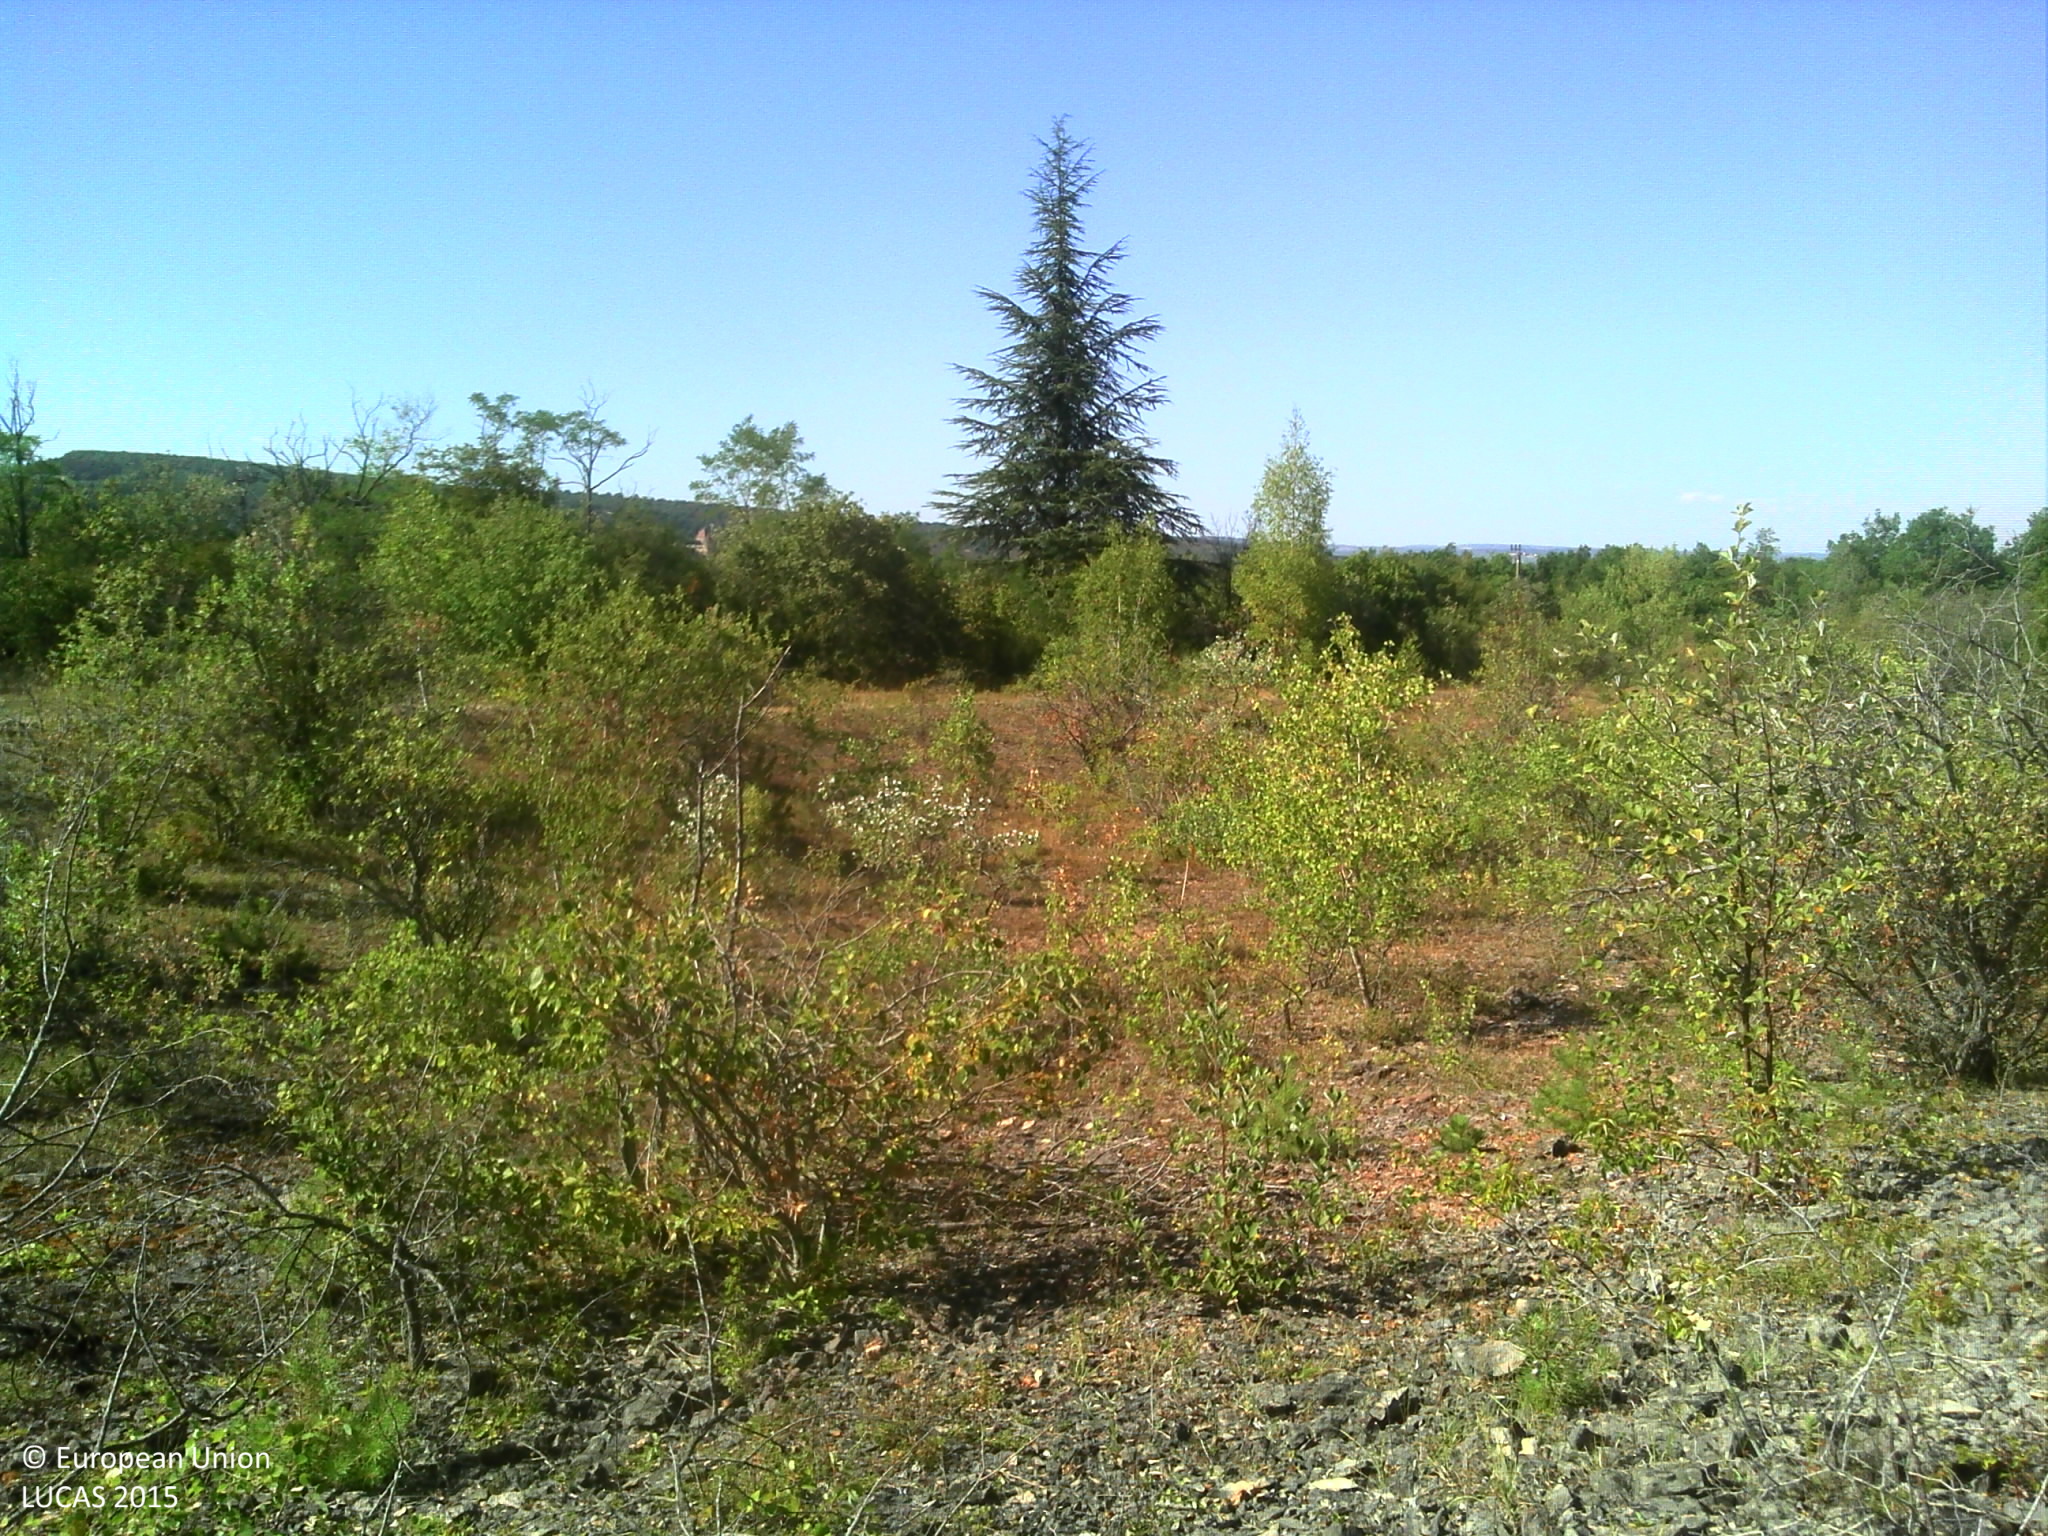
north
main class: Shrubland
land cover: Shrubland with sparse tree cover
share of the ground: > 75 %
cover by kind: shrubs 45 %, unconsolidated bare surface 30 %, herbaceous plants 20 %, broadleaved forest trees 5 %
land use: Semi-natural and natural areas not in use
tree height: < 5 m
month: July
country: FR
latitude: 46.8535
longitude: 4.7417
